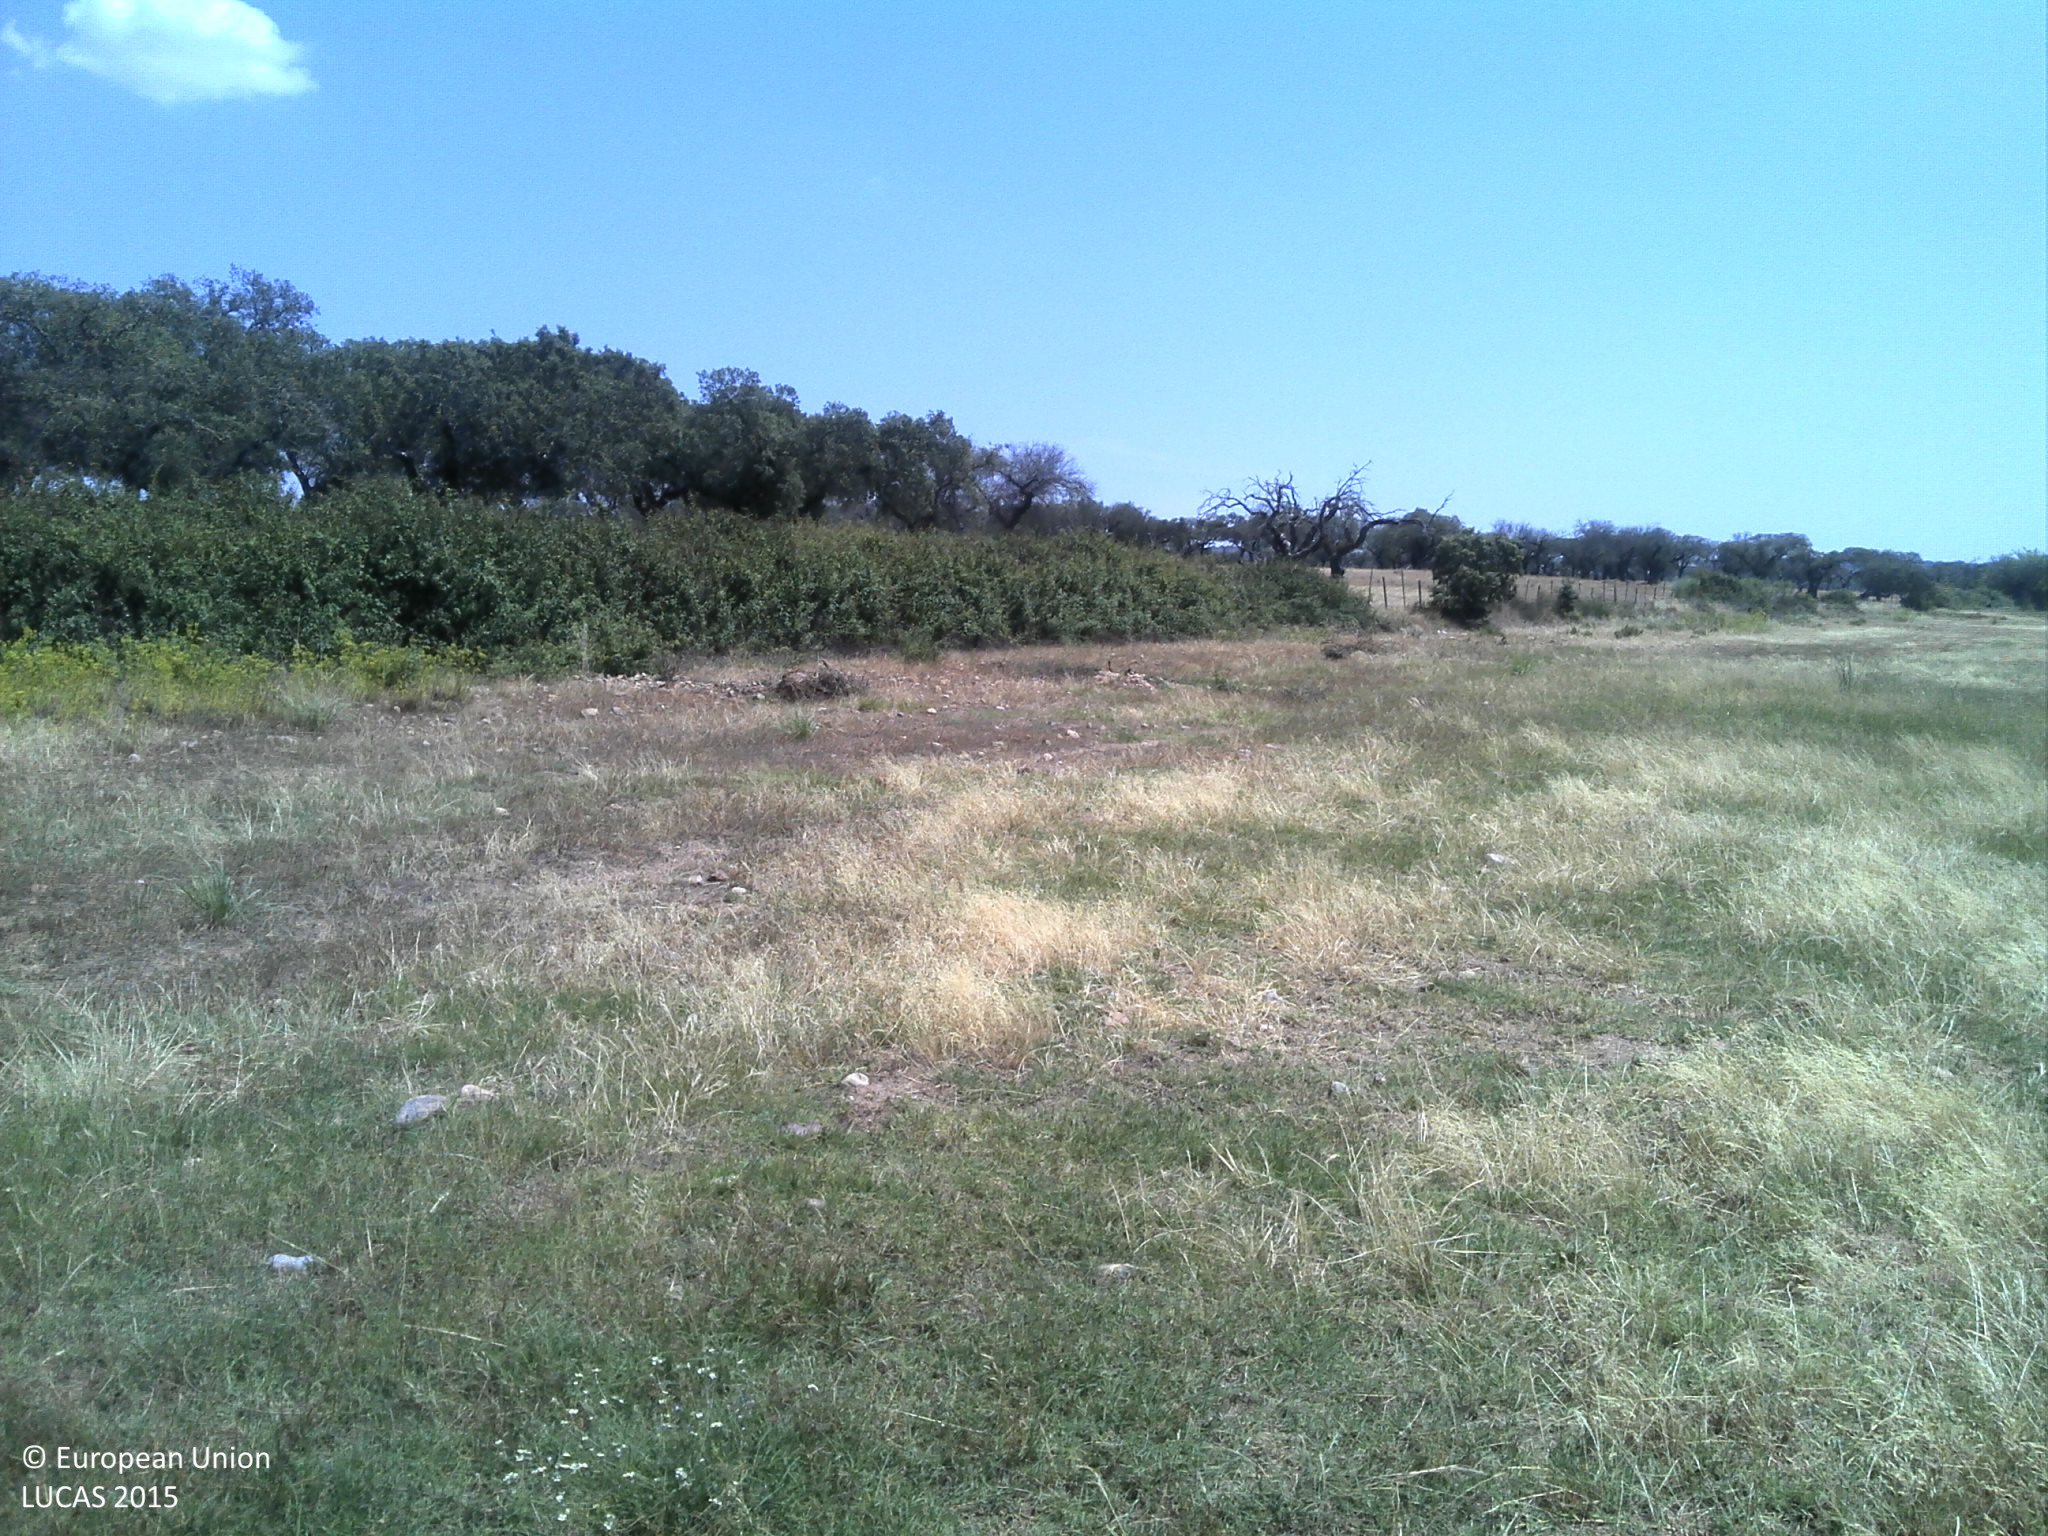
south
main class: Grassland
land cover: Grassland without tree/shrub cover
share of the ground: 50 - 75 %
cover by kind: herbaceous plants 50 %, unconsolidated bare surface 40 %, shrubs 5 %
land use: Agriculture (excluding fallow land and kitchen gardens)
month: June
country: PT
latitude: 39.8739
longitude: -7.1261
